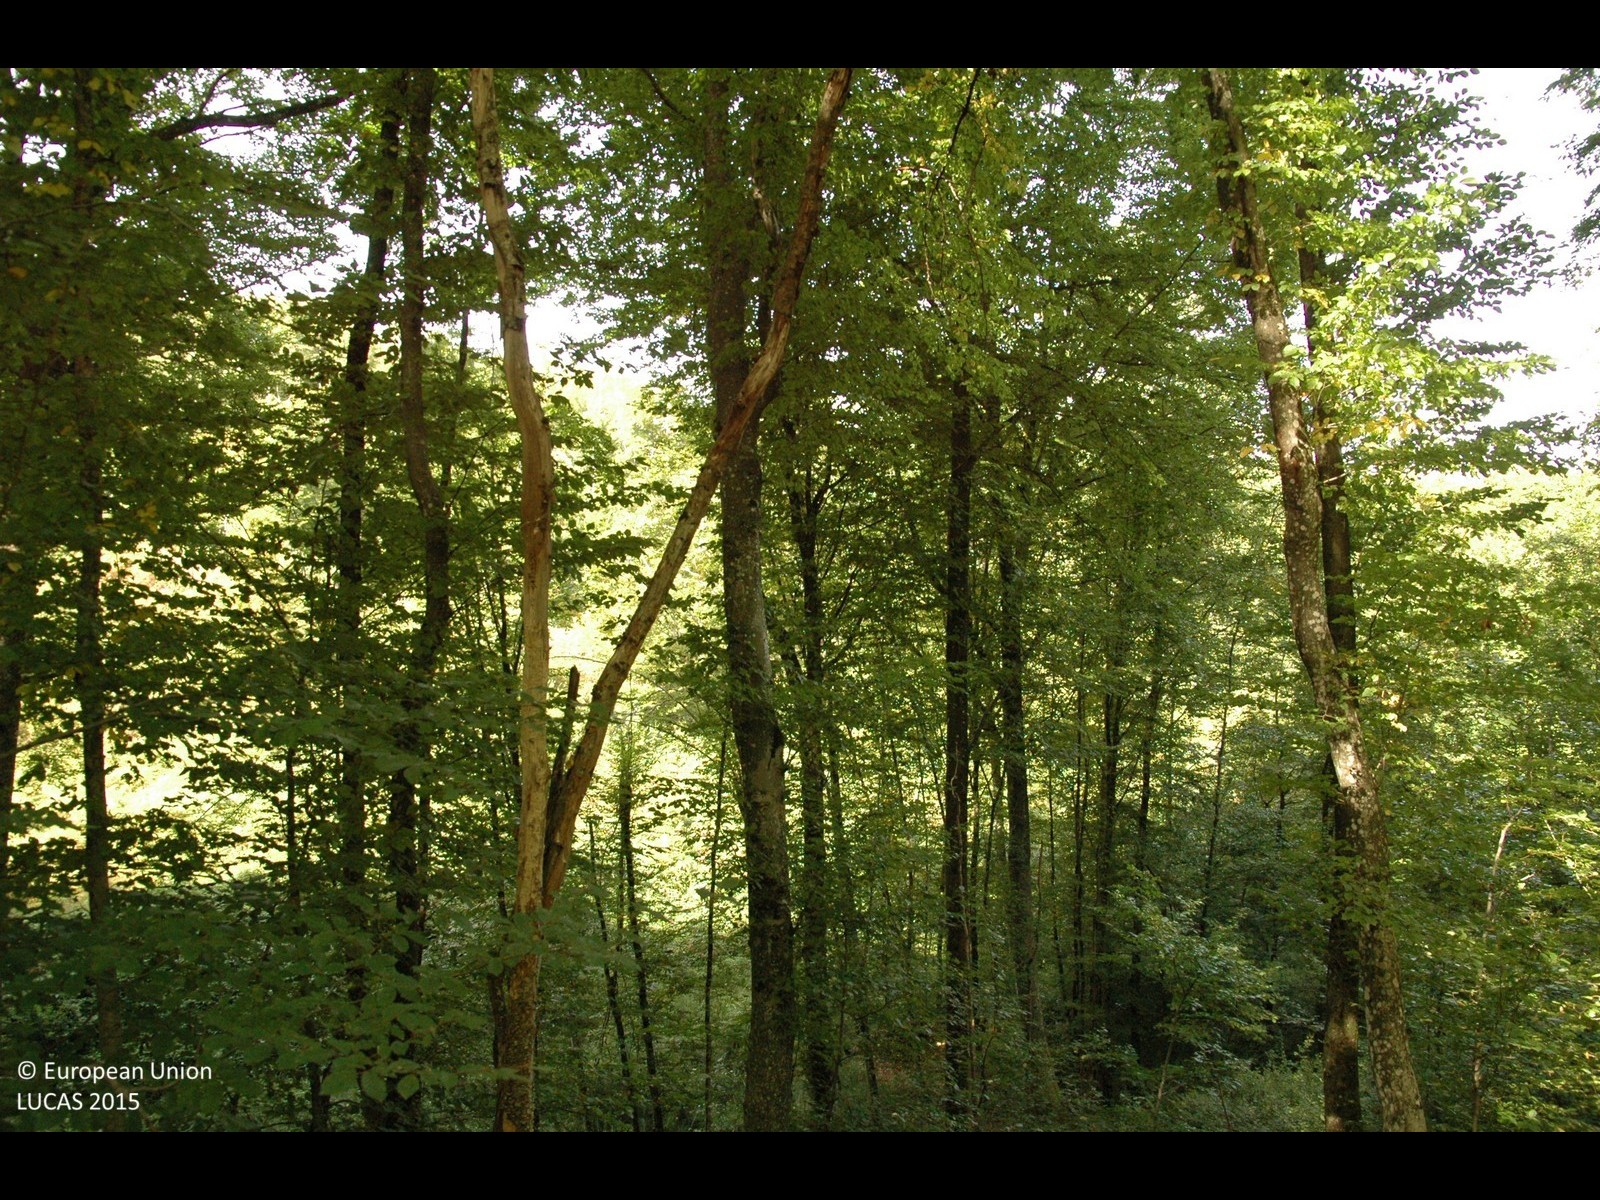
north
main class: Woodland
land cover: Broadleaved woodland
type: mesophytic deciduous forest
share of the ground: > 75 %
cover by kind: broadleaved forest trees 100 %
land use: Forestry
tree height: > 5 m
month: September
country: HR
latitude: 45.5740
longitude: 15.9045
